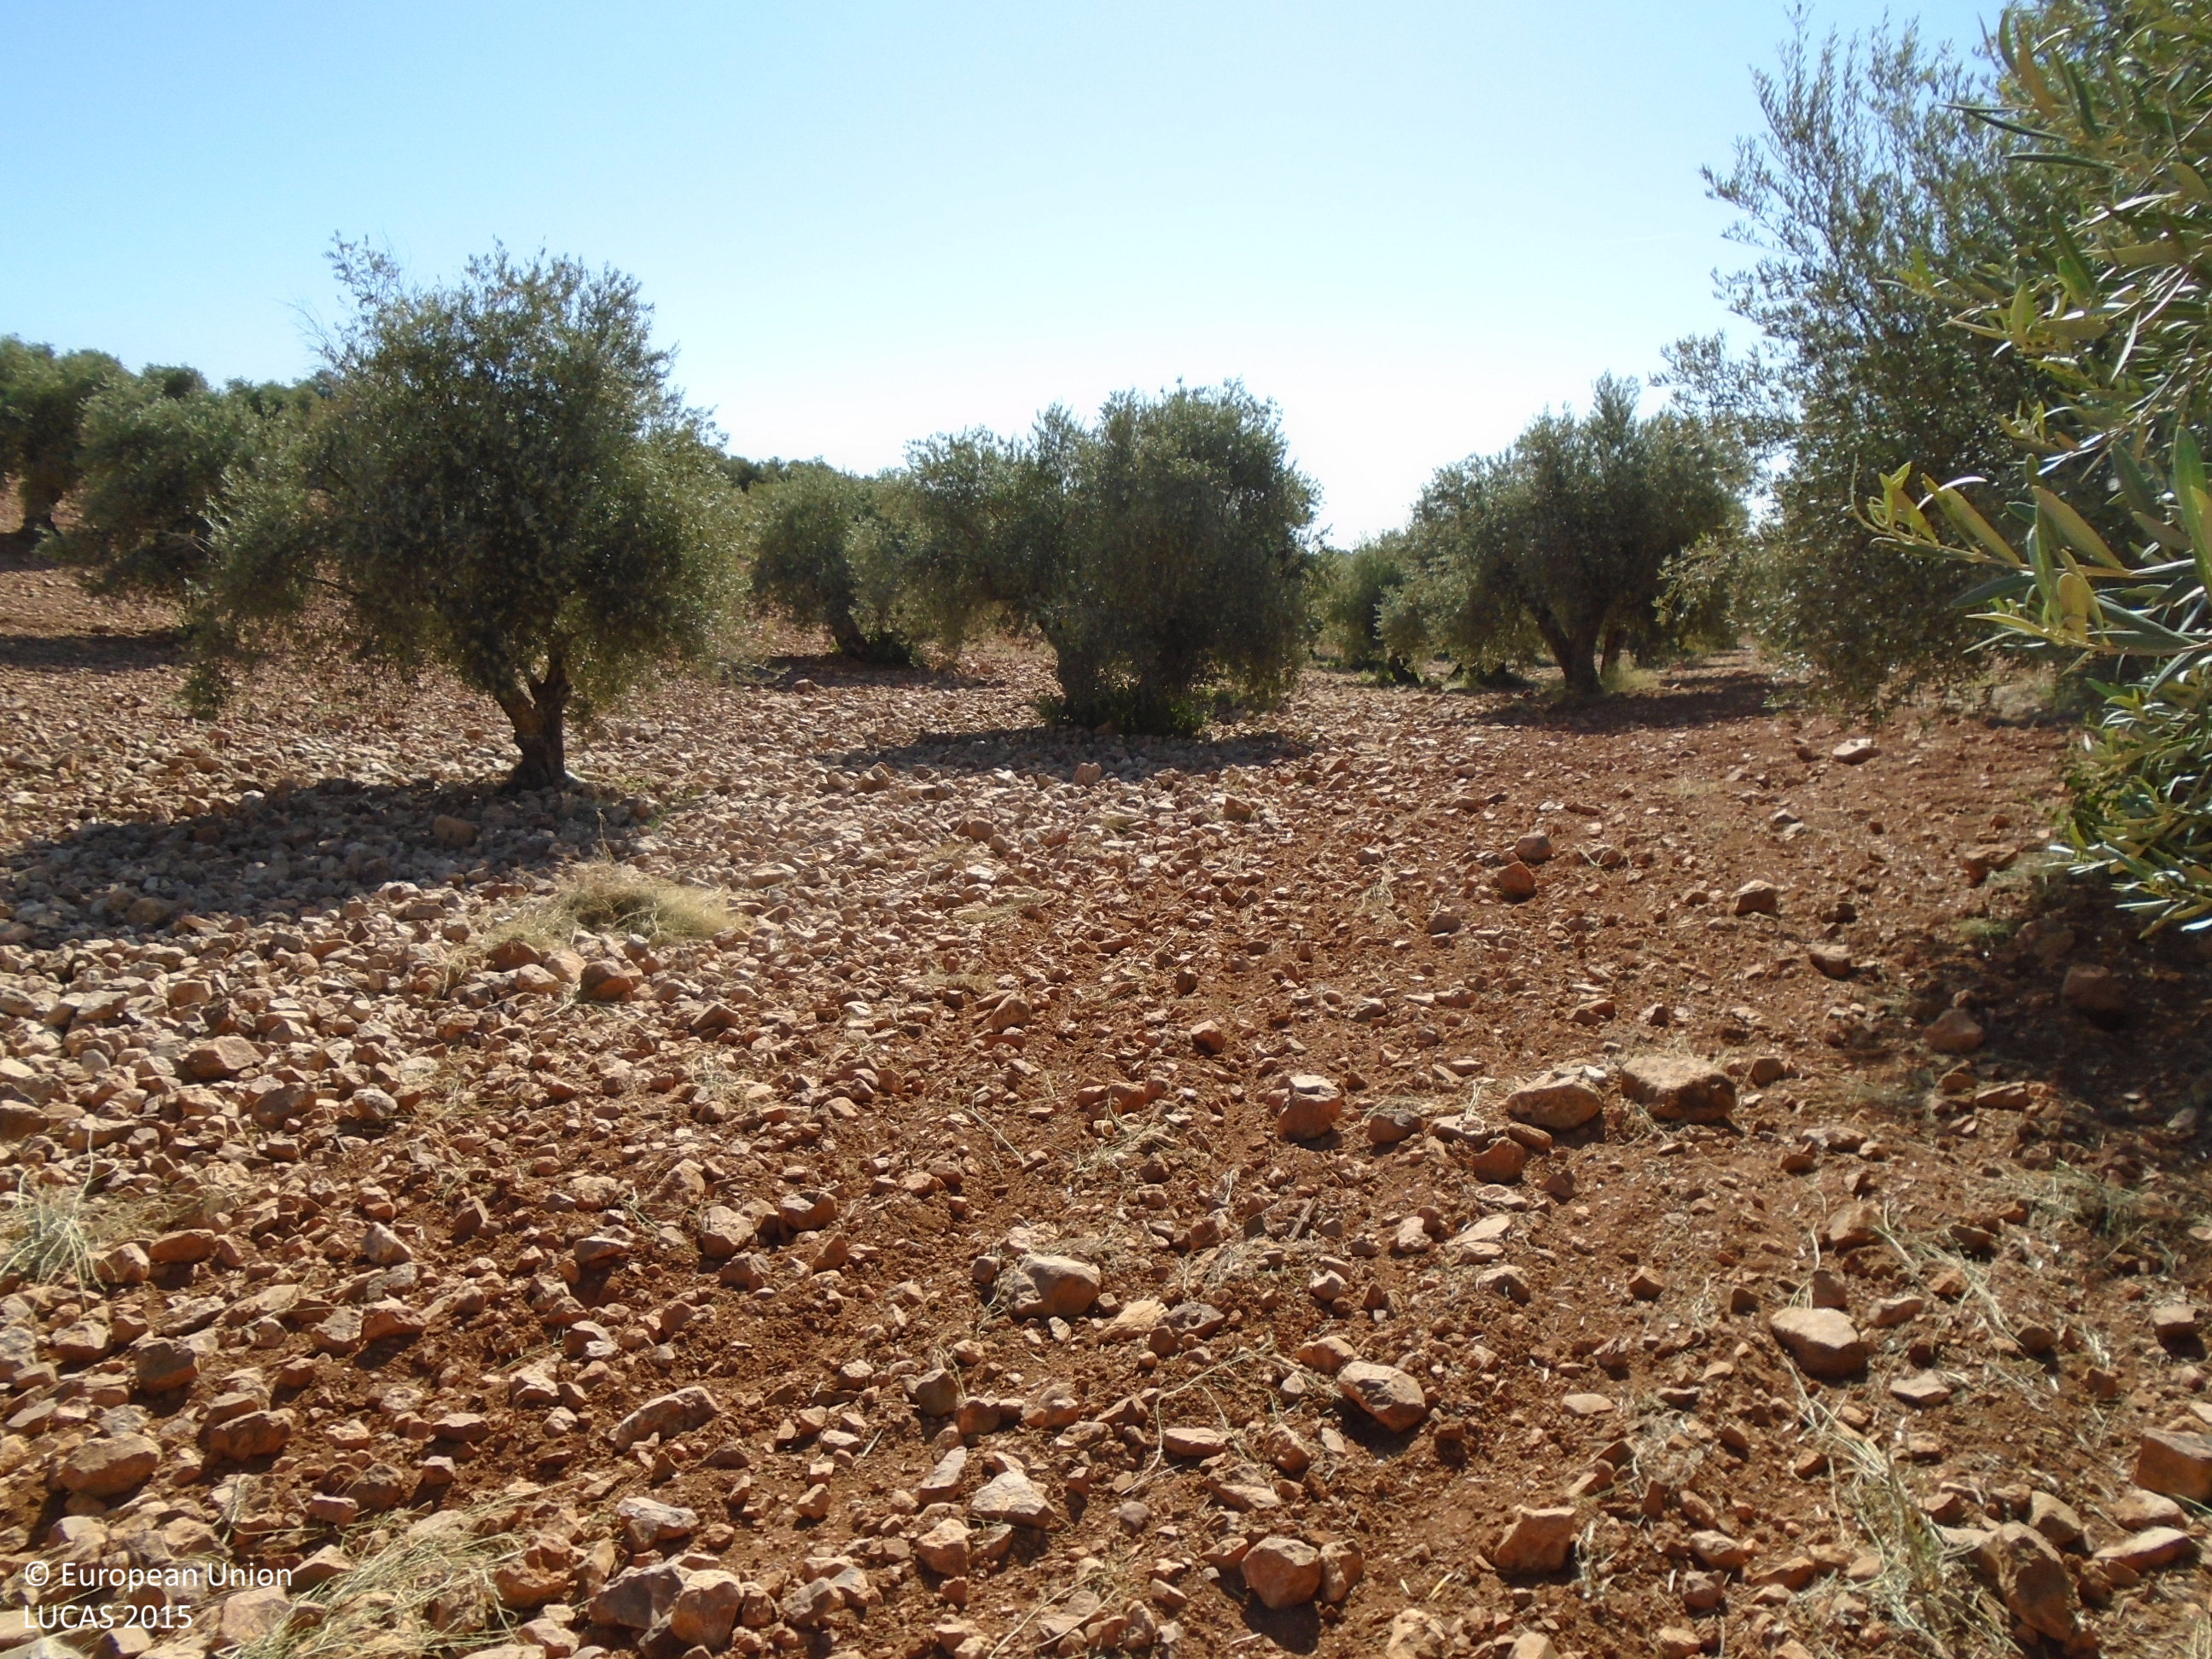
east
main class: Cropland
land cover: Olive groves
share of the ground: 10 - 25 %
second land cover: Other bare soil
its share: > 75 %
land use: Agriculture (excluding fallow land and kitchen gardens)
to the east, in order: Olive groves; Other bare soil; Abandoned hedges; Olive groves; Abandoned hedges; Olive groves
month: May
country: ES
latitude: 39.7209
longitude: -3.7125
